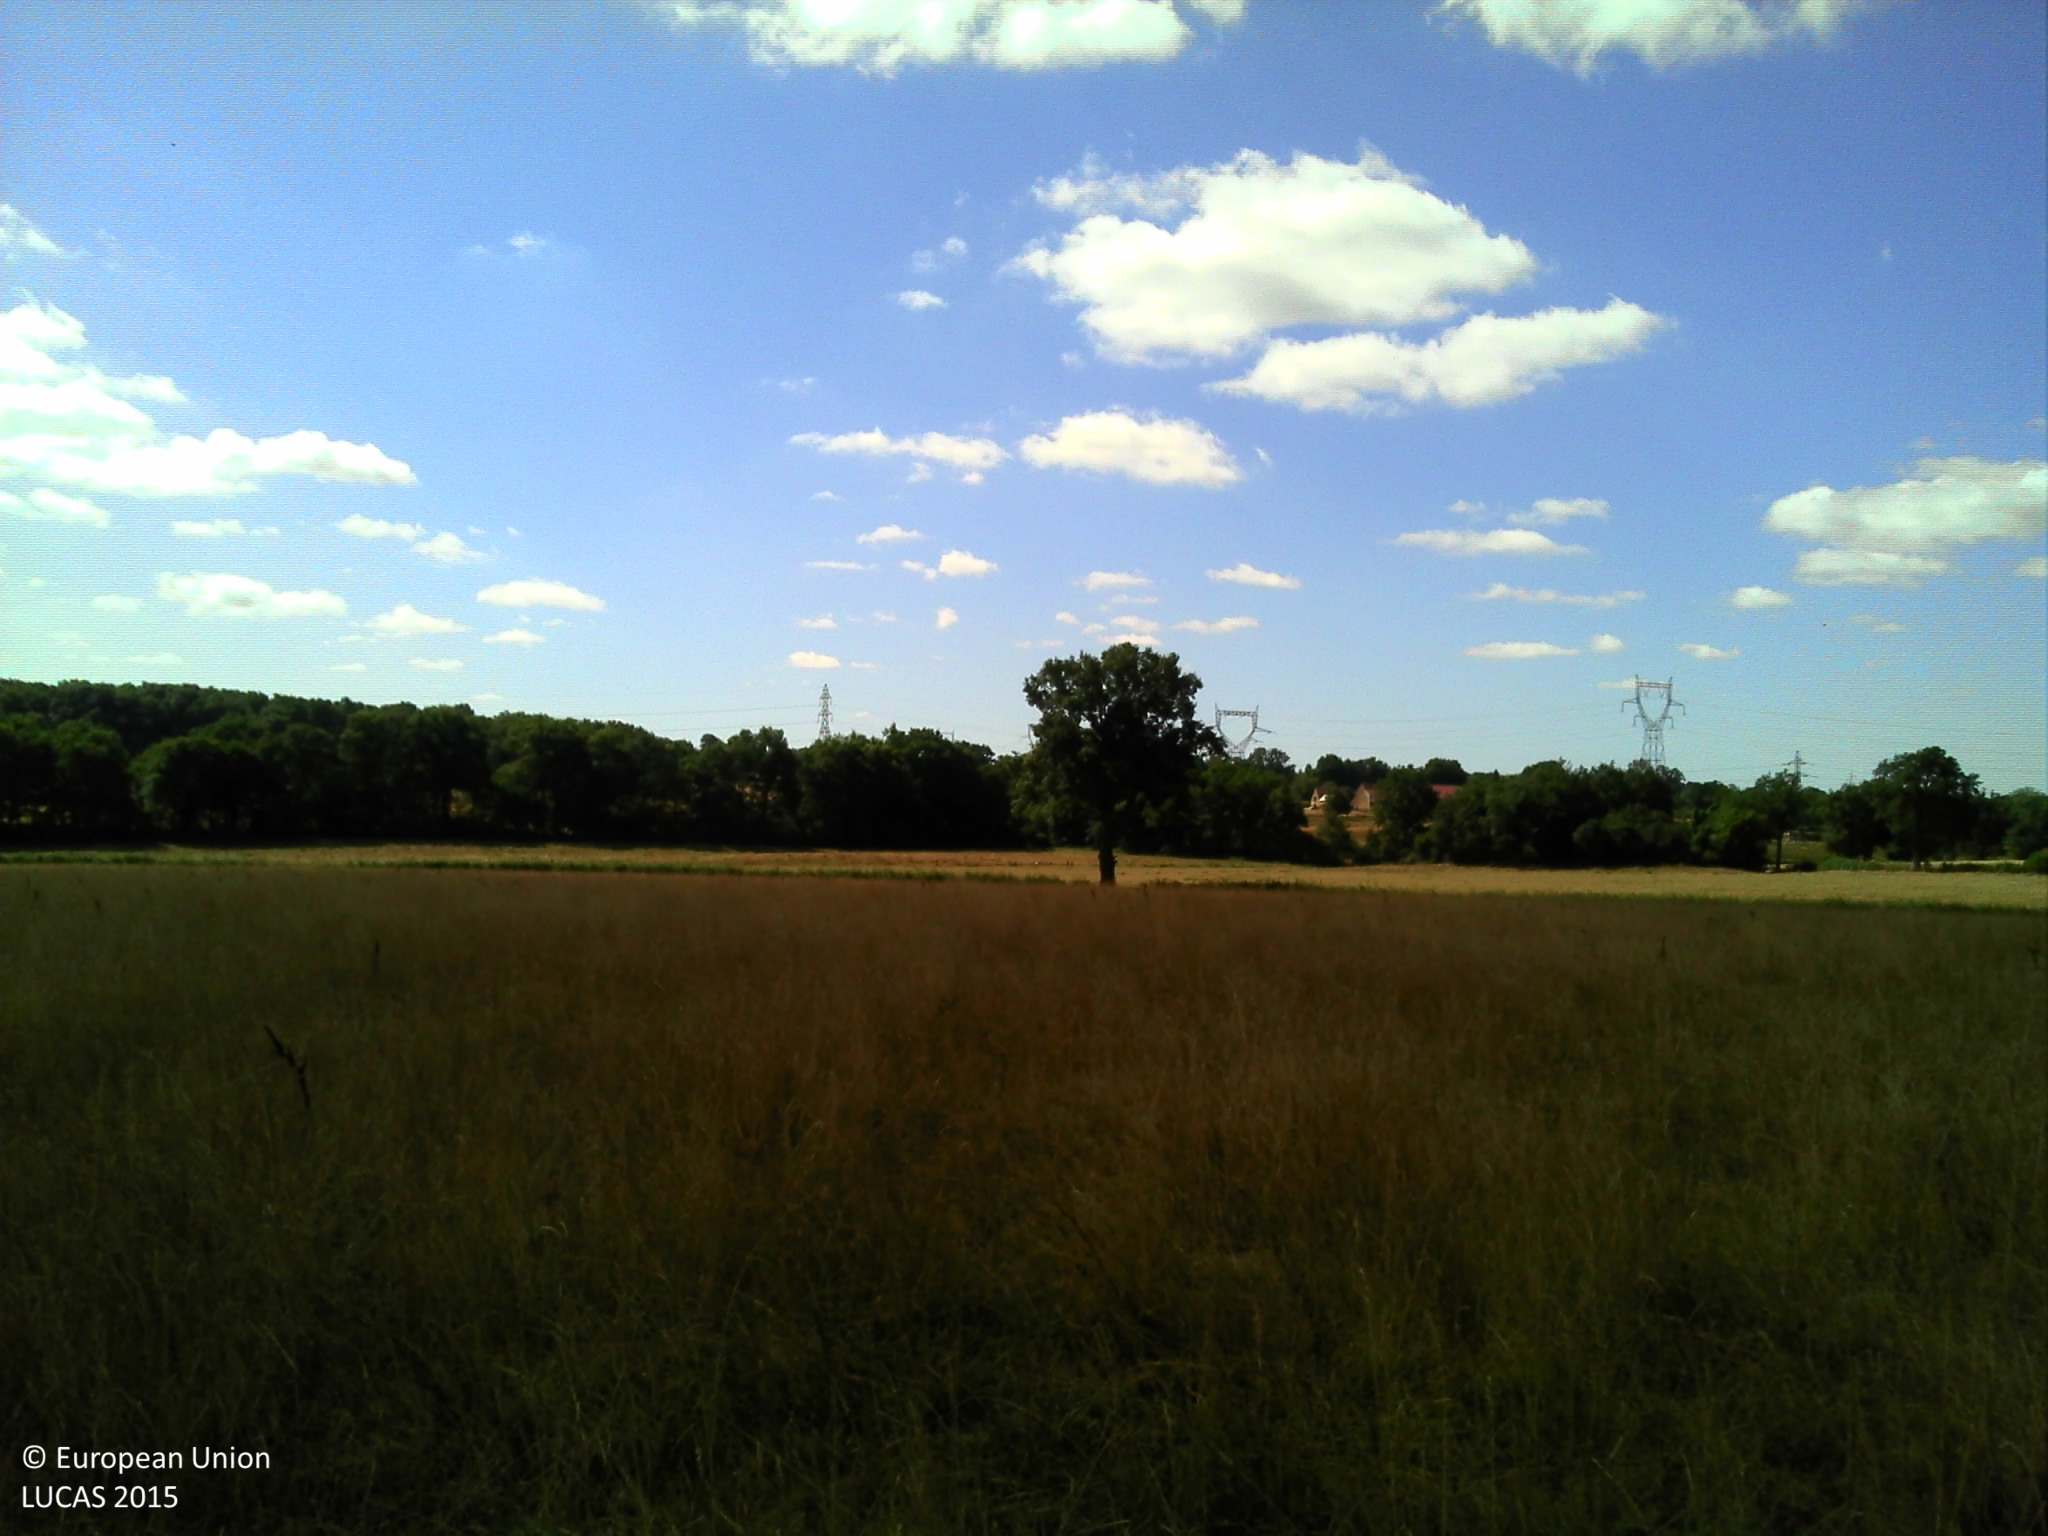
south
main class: Grassland
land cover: Grassland without tree/shrub cover
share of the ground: > 75 %
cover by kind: herbaceous plants 100 %
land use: Agriculture (excluding fallow land and kitchen gardens)
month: July
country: FR
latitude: 46.5568
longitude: 3.0186
